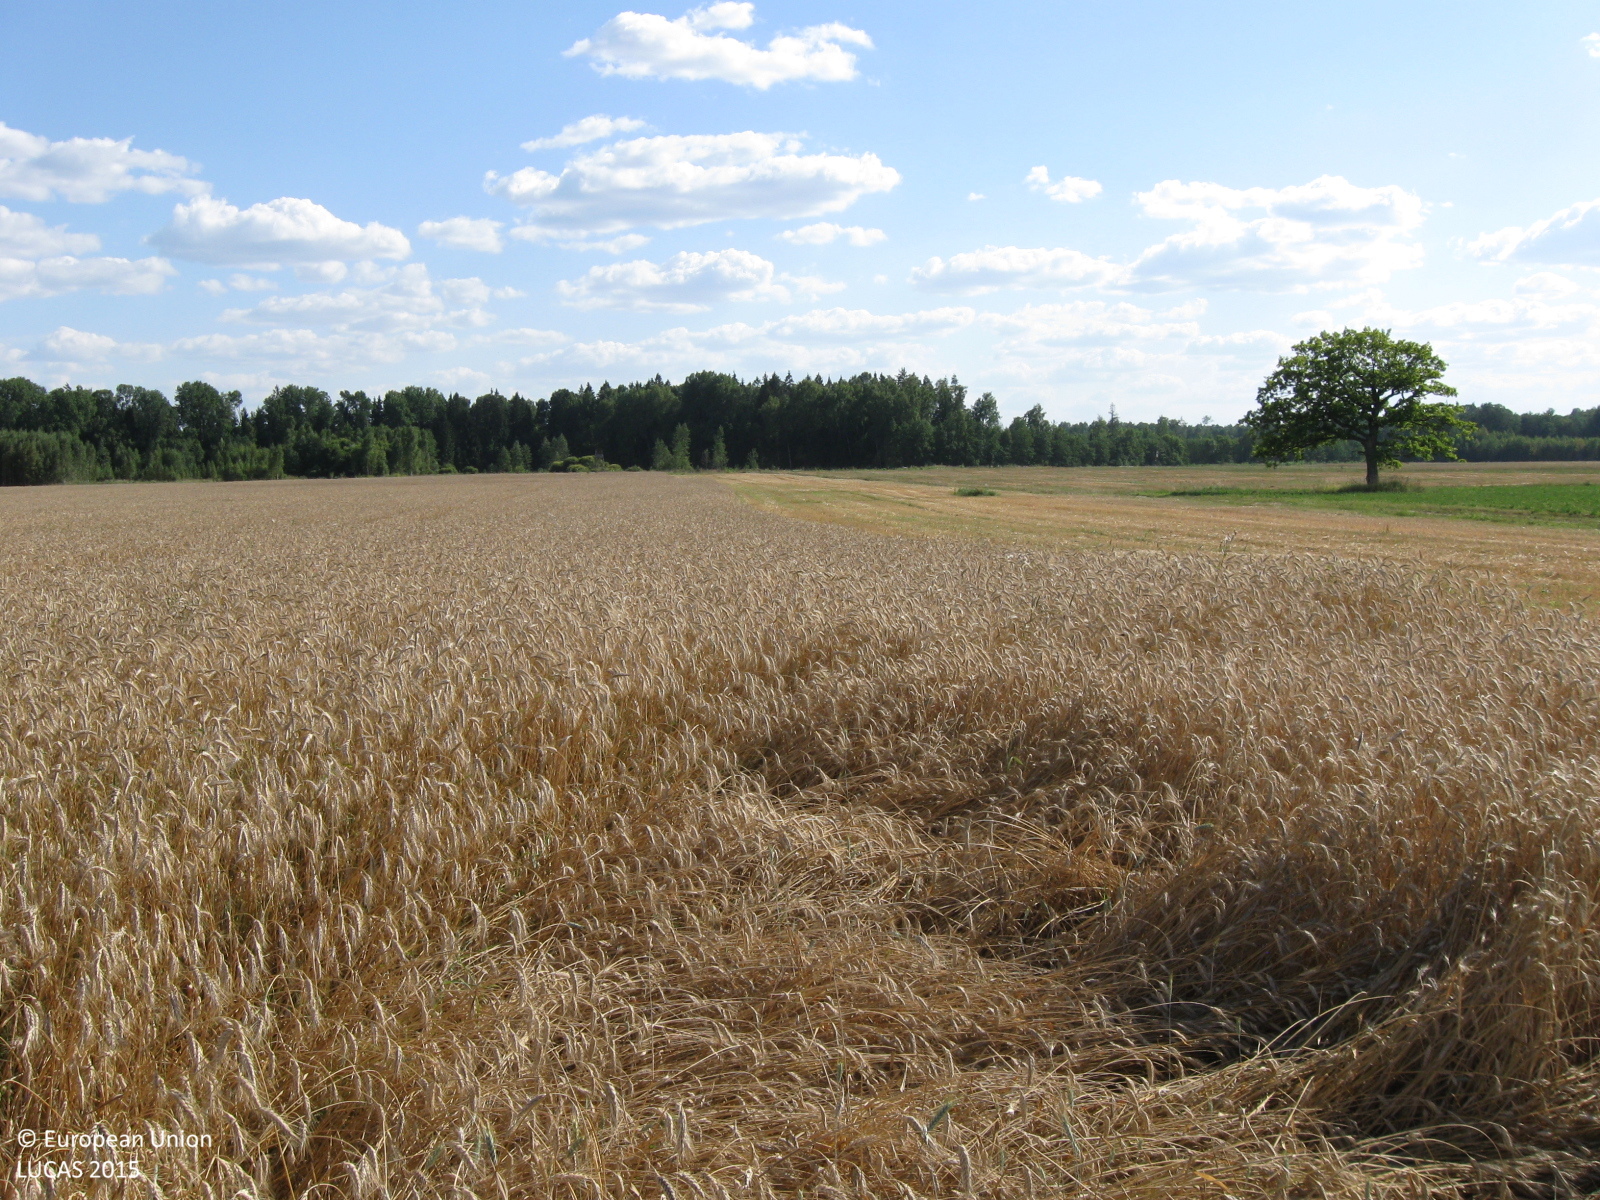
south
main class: Cropland
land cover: Triticale
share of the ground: > 75 %
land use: Agriculture (excluding fallow land and kitchen gardens)
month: August
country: LT
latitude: 55.2390
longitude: 22.5657
